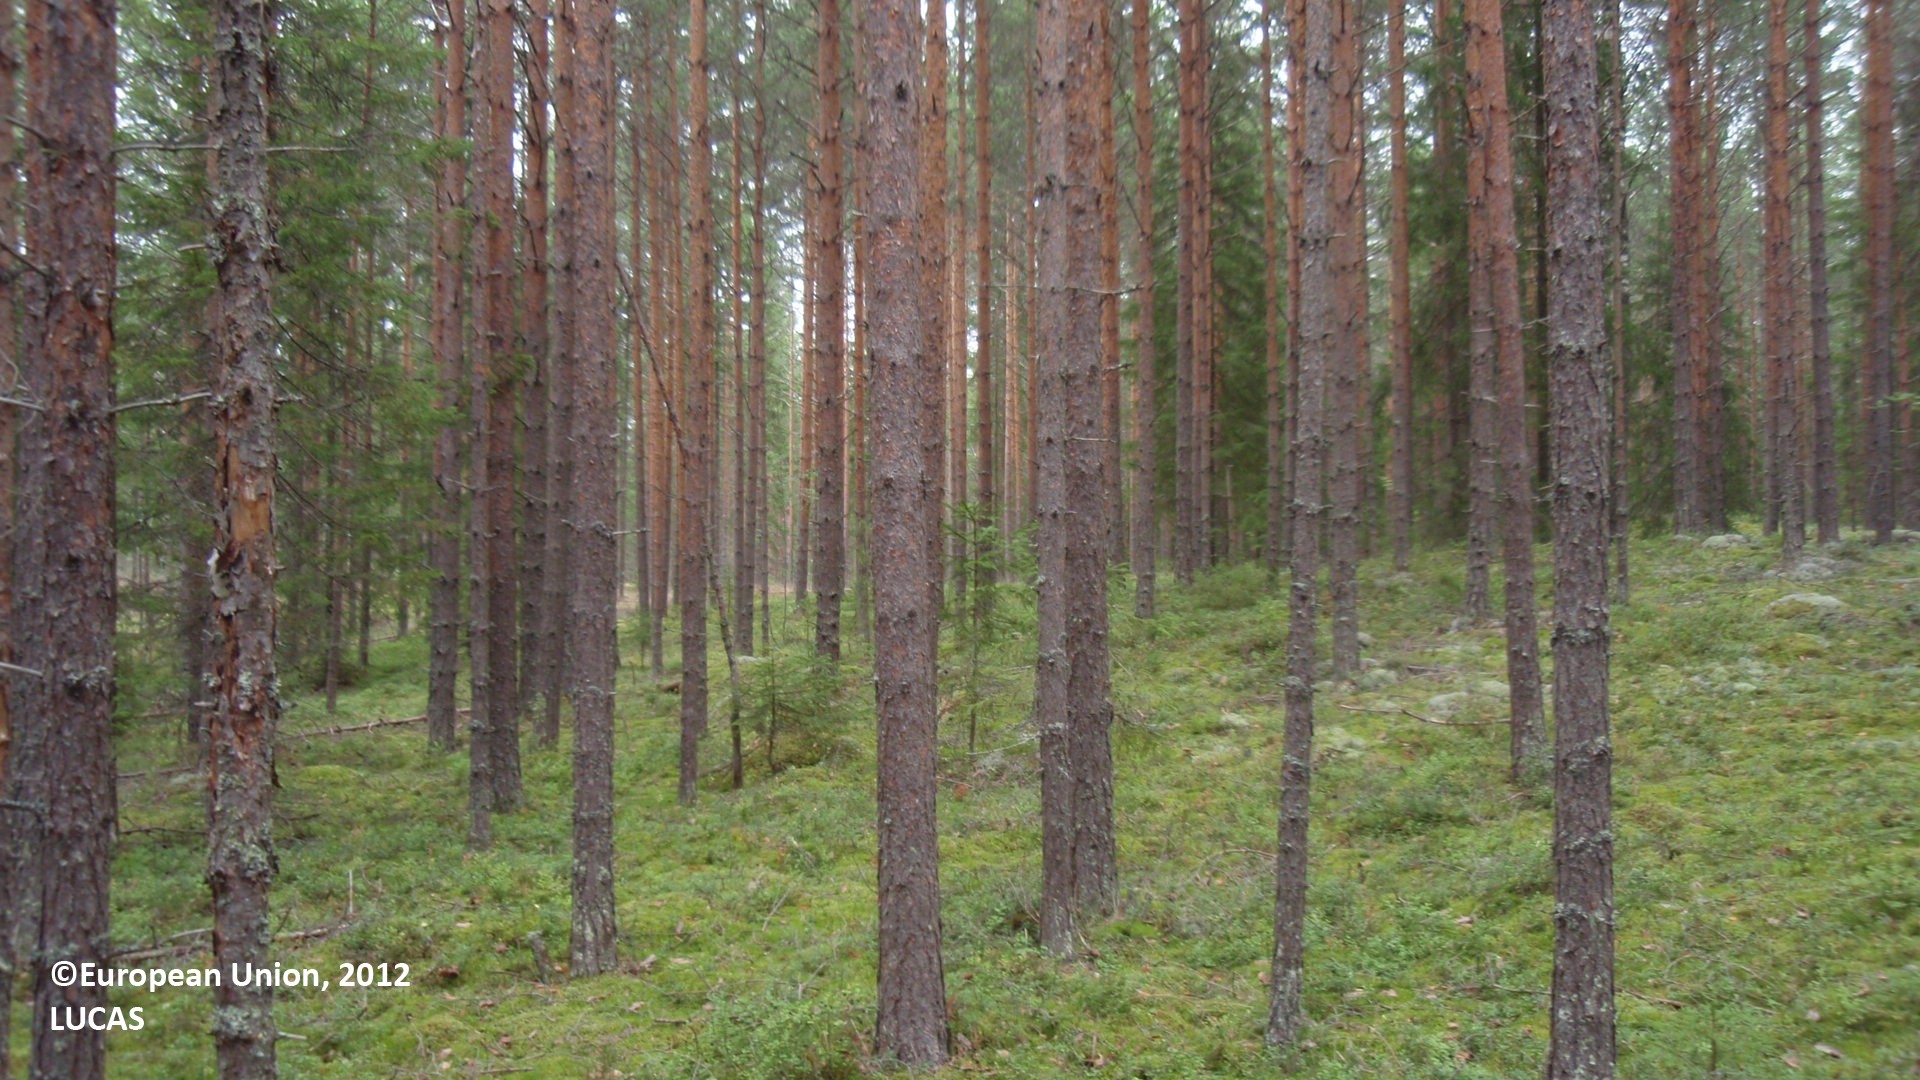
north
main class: Woodland
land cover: Pine dominated mixed woodland
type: boreal forest
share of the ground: 50 - 75 %
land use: Forestry
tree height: > 5 m
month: August
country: FI
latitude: 60.9331
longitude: 27.4334
